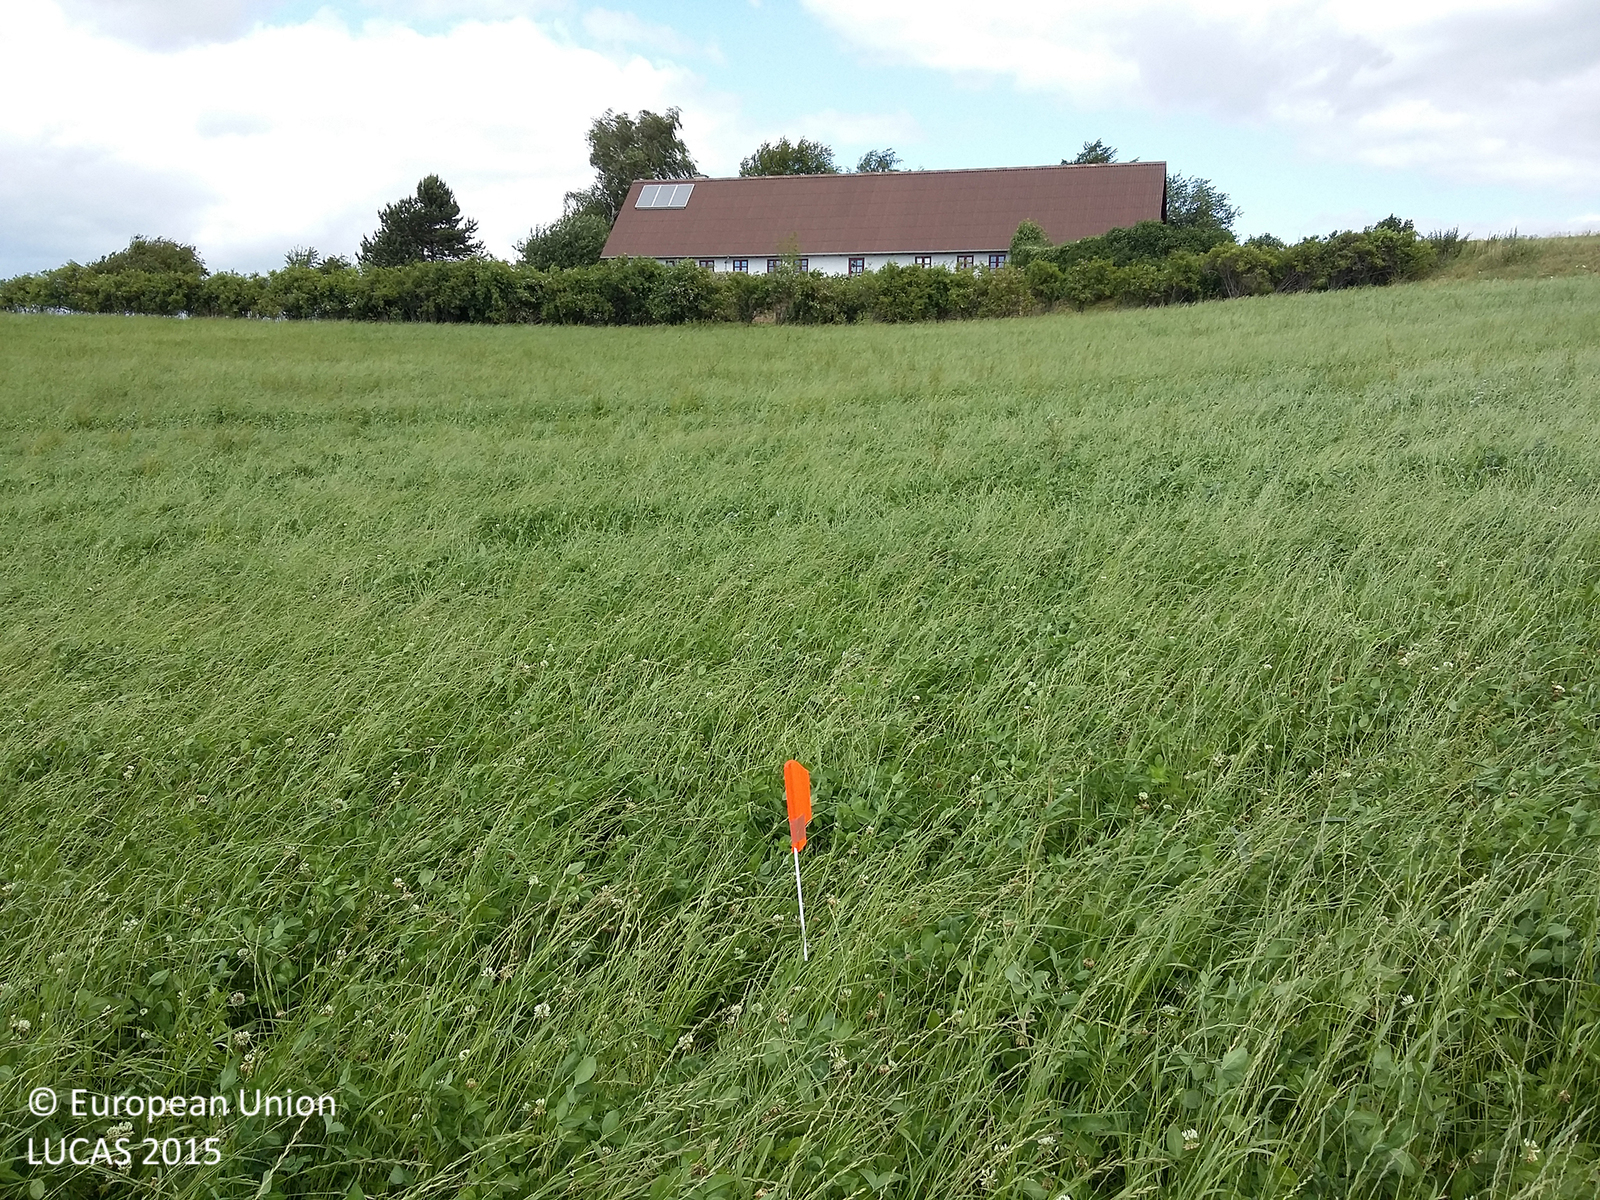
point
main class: Cropland
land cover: Clovers
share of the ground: > 75 %
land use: Agriculture (excluding fallow land and kitchen gardens)
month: July
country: DK
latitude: 55.2208
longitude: 11.9006
